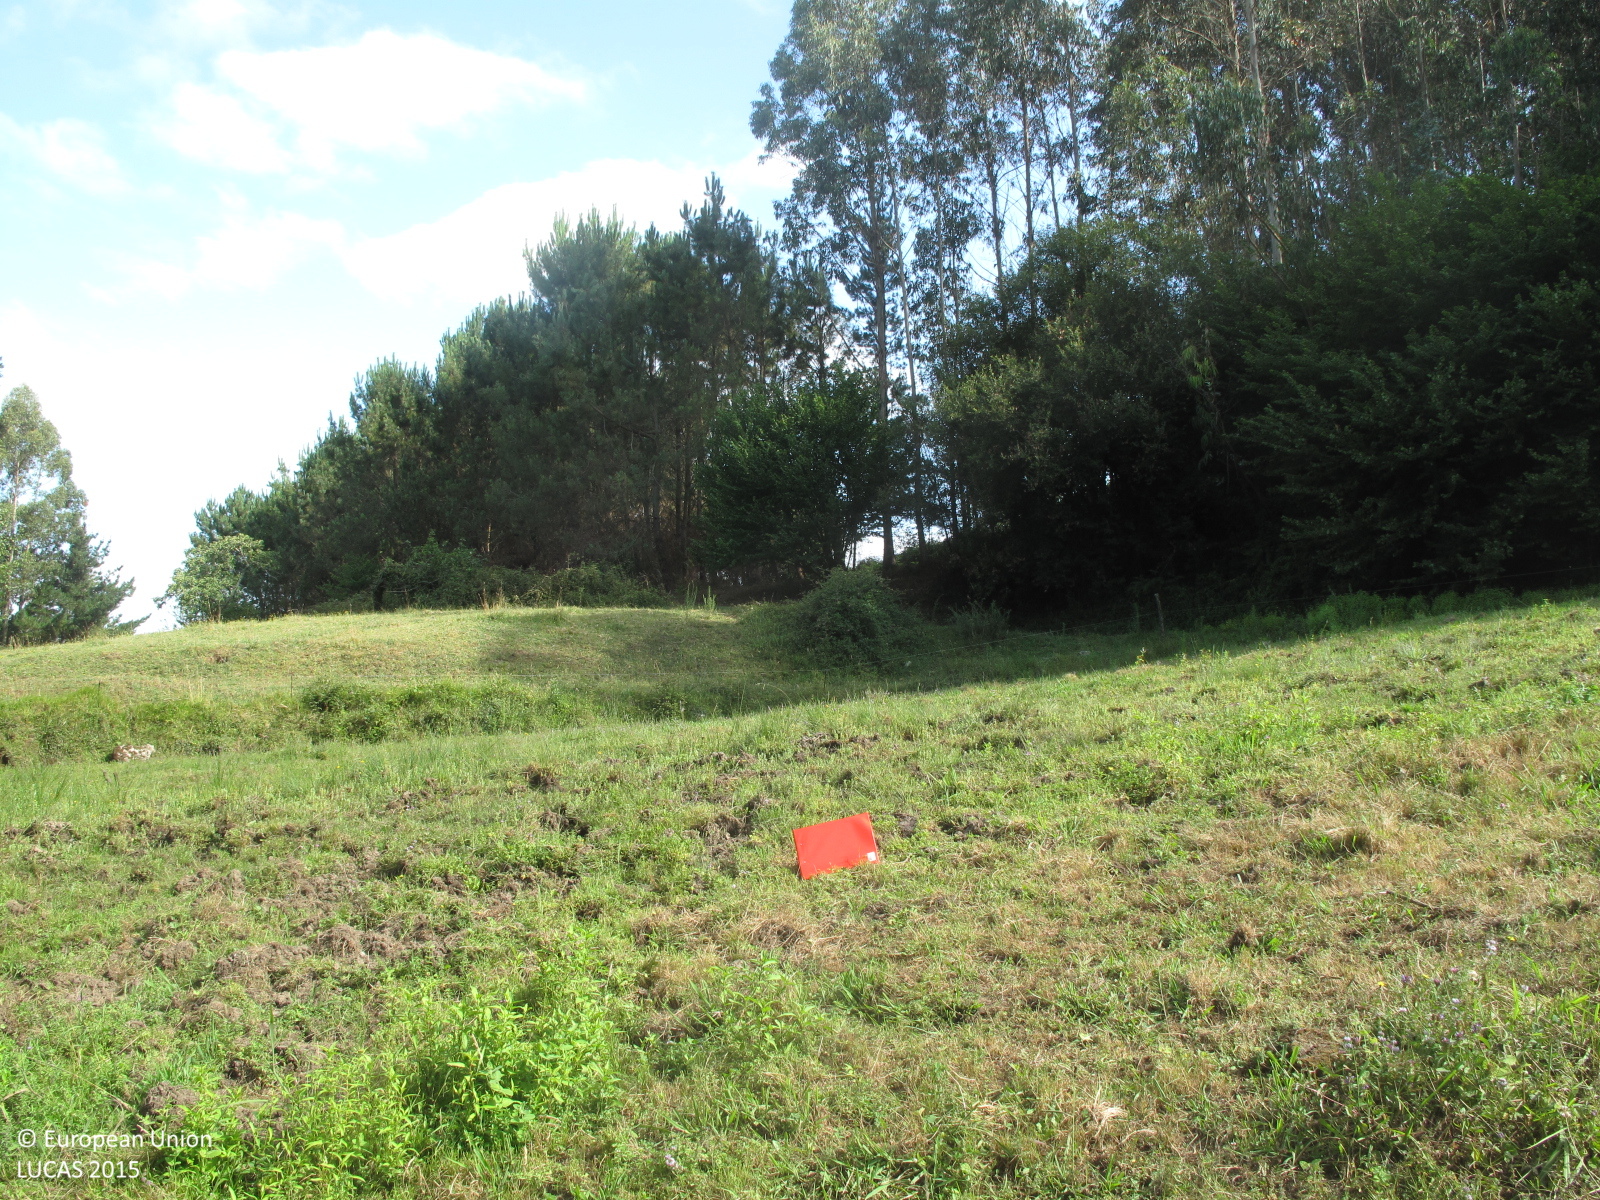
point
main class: Grassland
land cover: Grassland with sparse tree/shrub cover
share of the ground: > 75 %
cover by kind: herbaceous plants 95 %, broadleaved forest trees 5 %
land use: Agriculture (excluding fallow land and kitchen gardens)
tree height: < 5 m
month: July
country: ES
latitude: 43.3082
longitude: -8.1344
